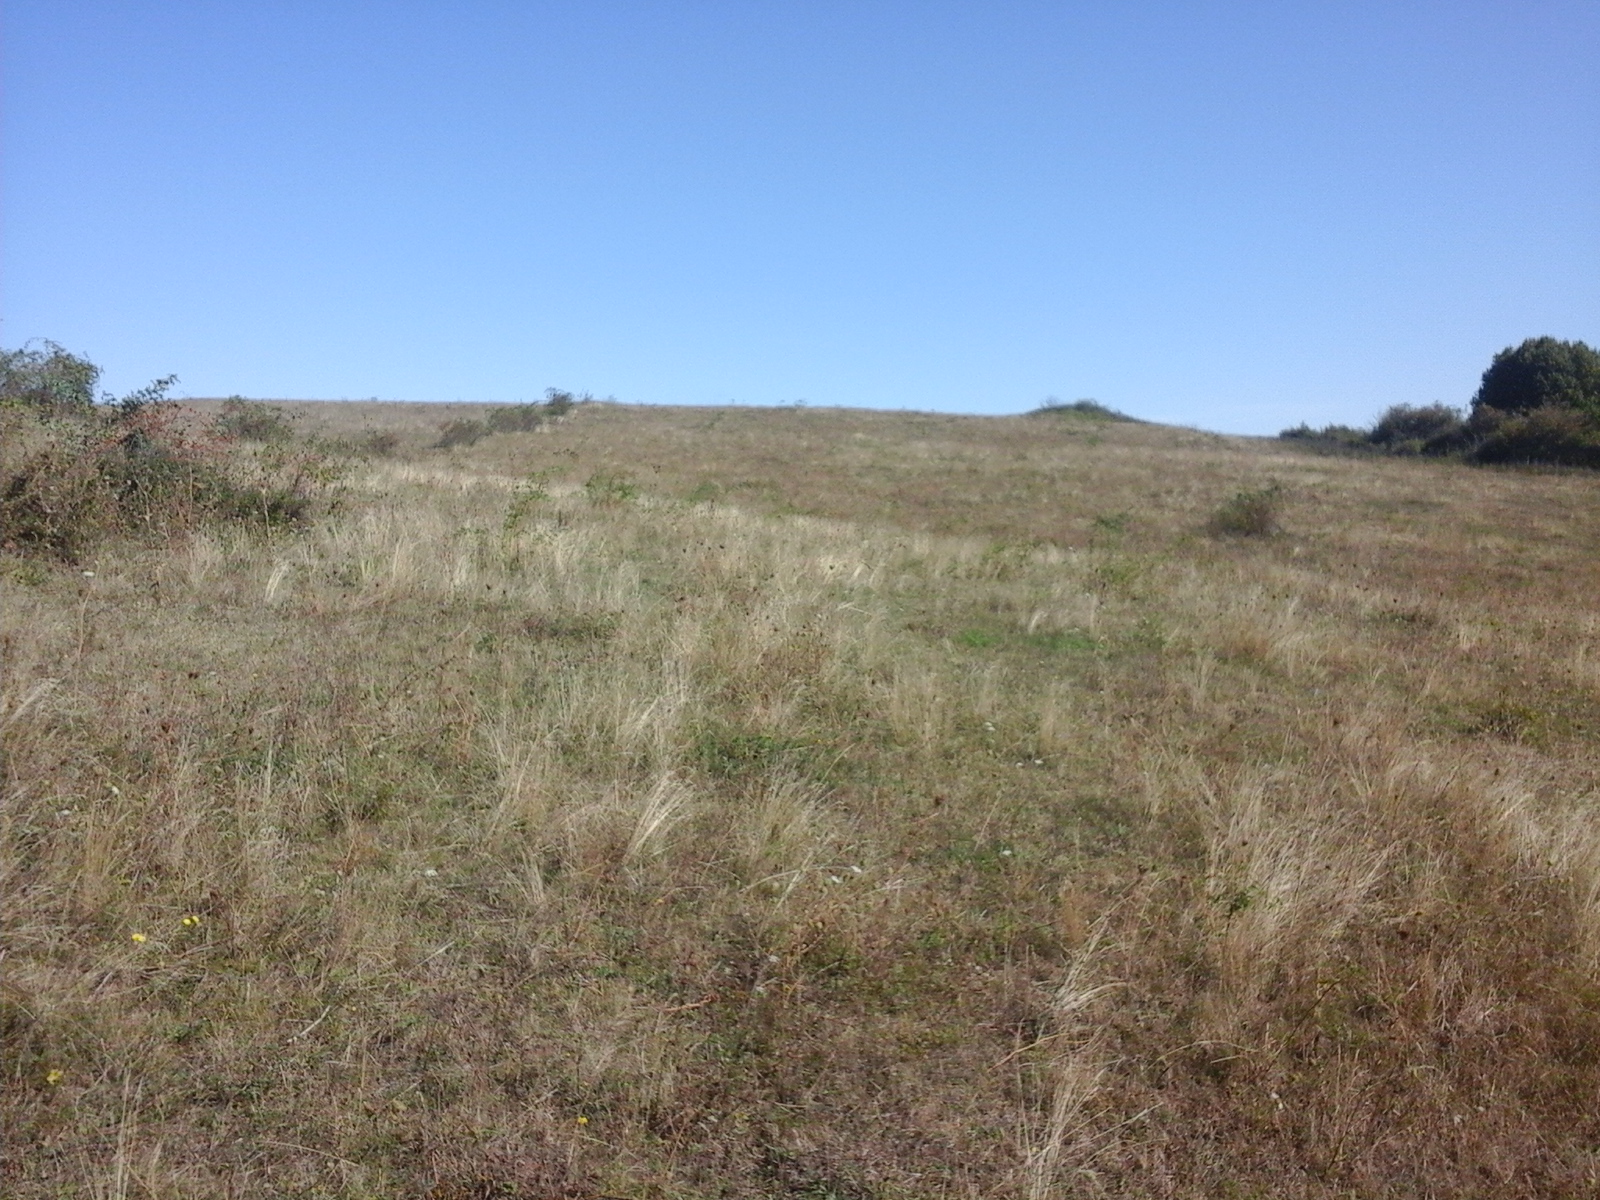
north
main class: Grassland
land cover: Grassland without tree/shrub cover
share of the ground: > 75 %
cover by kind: herbaceous plants 100 %
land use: Agriculture (excluding fallow land and kitchen gardens)
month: September
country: RO
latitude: 47.4004
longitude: 23.5496
